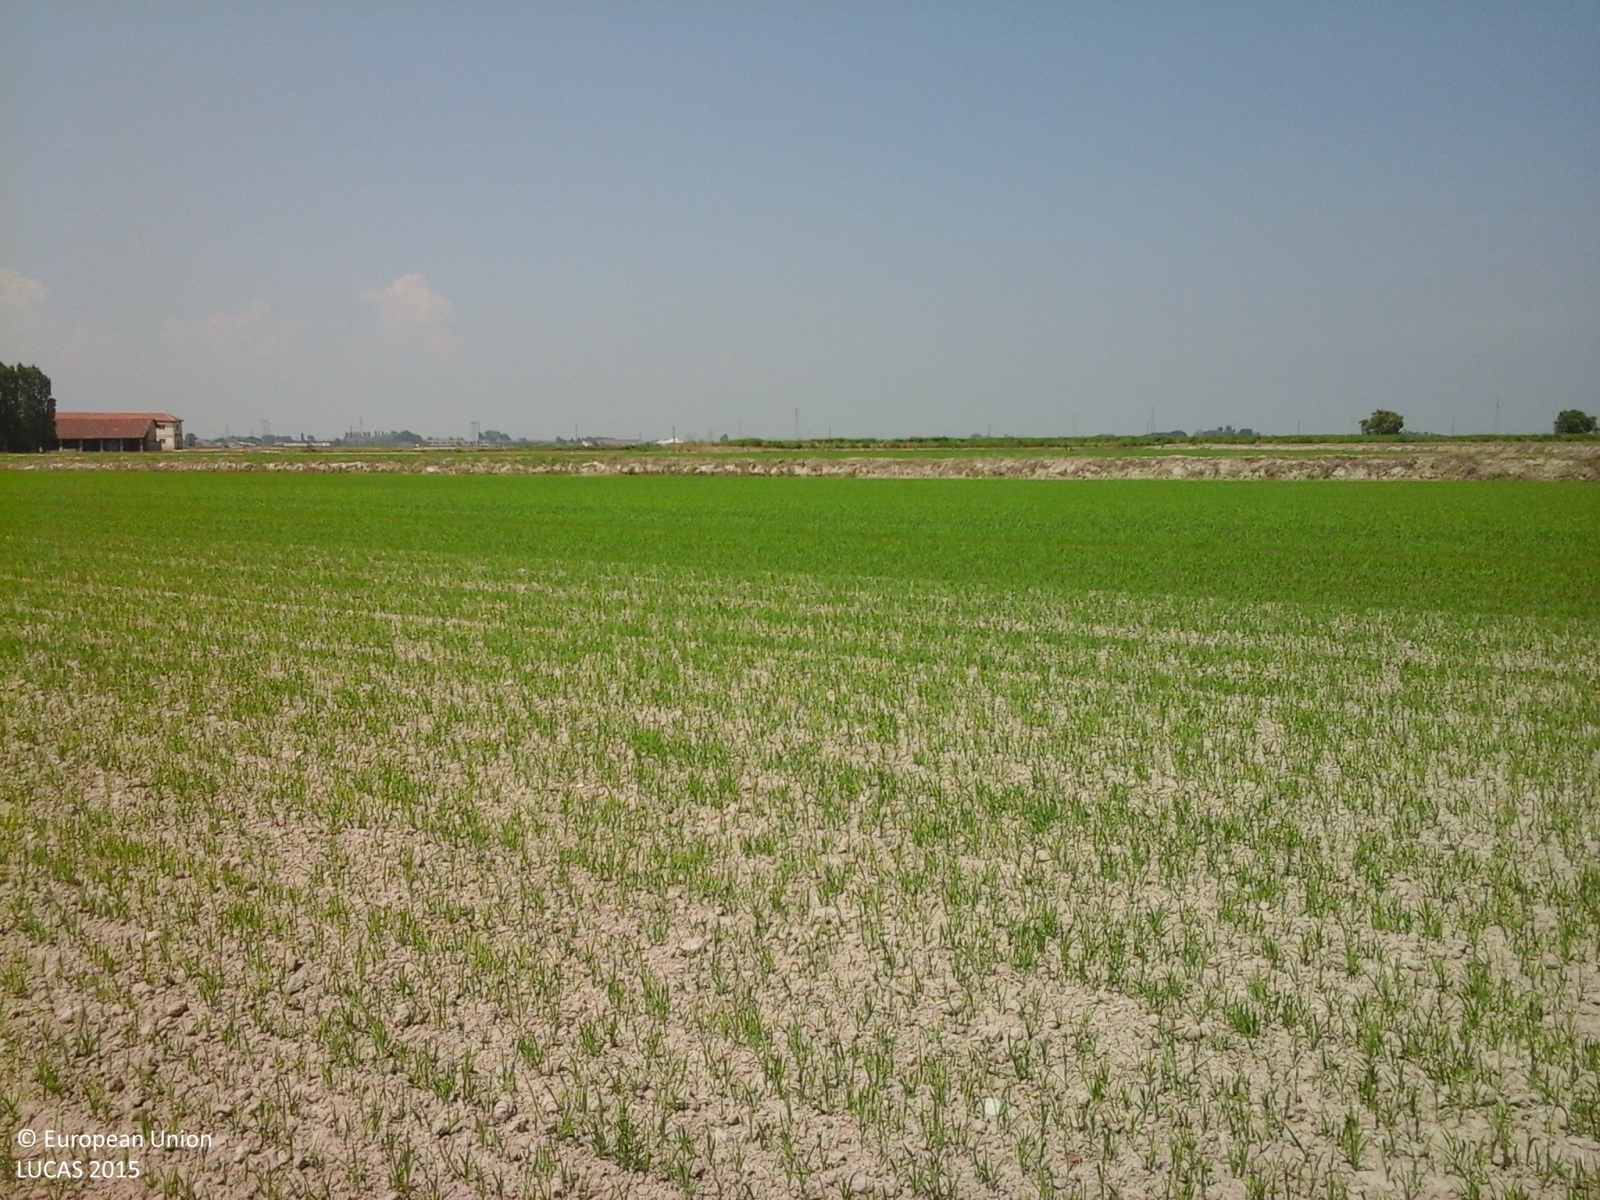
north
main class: Cropland
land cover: Rice
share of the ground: 25 - 50 %
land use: Agriculture (excluding fallow land and kitchen gardens)
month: June
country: IT
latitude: 45.1664
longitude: 8.3109
